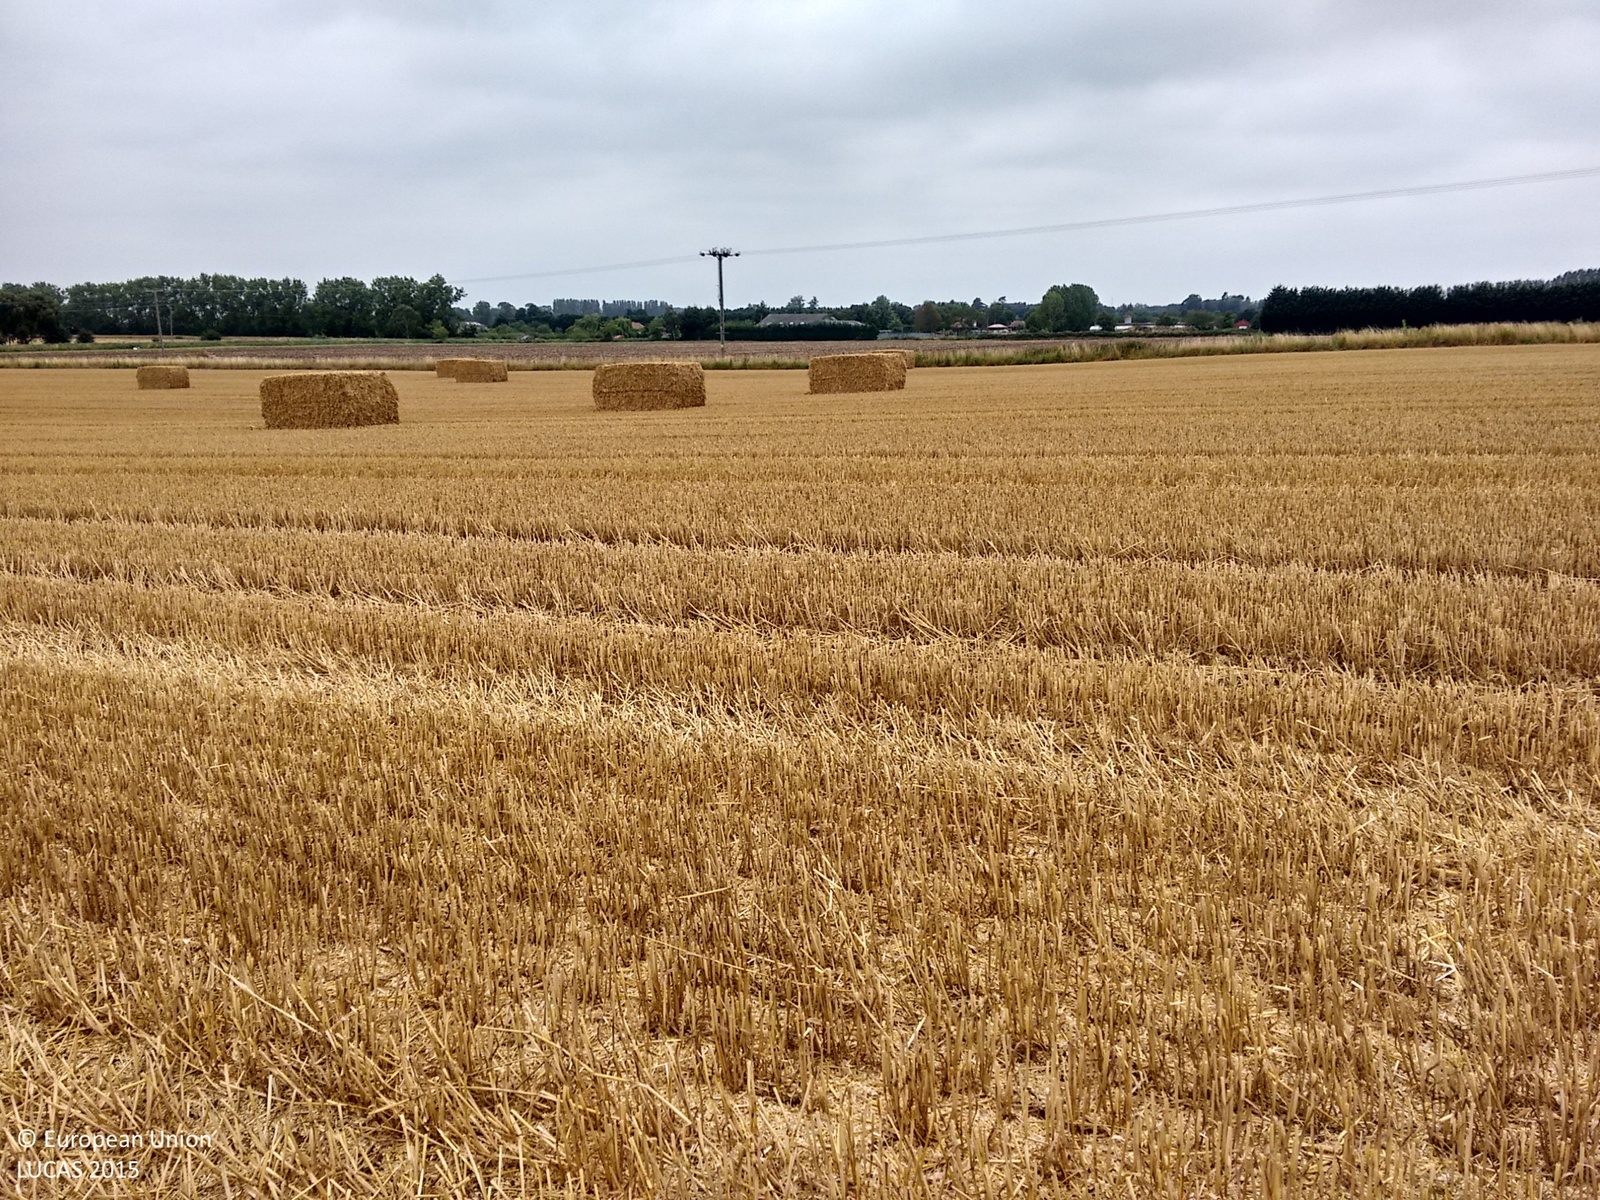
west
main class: Cropland
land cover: Common wheat
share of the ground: > 75 %
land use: Agriculture (excluding fallow land and kitchen gardens)
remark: Harvested field
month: August
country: GB
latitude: 52.3520
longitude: 0.2064
